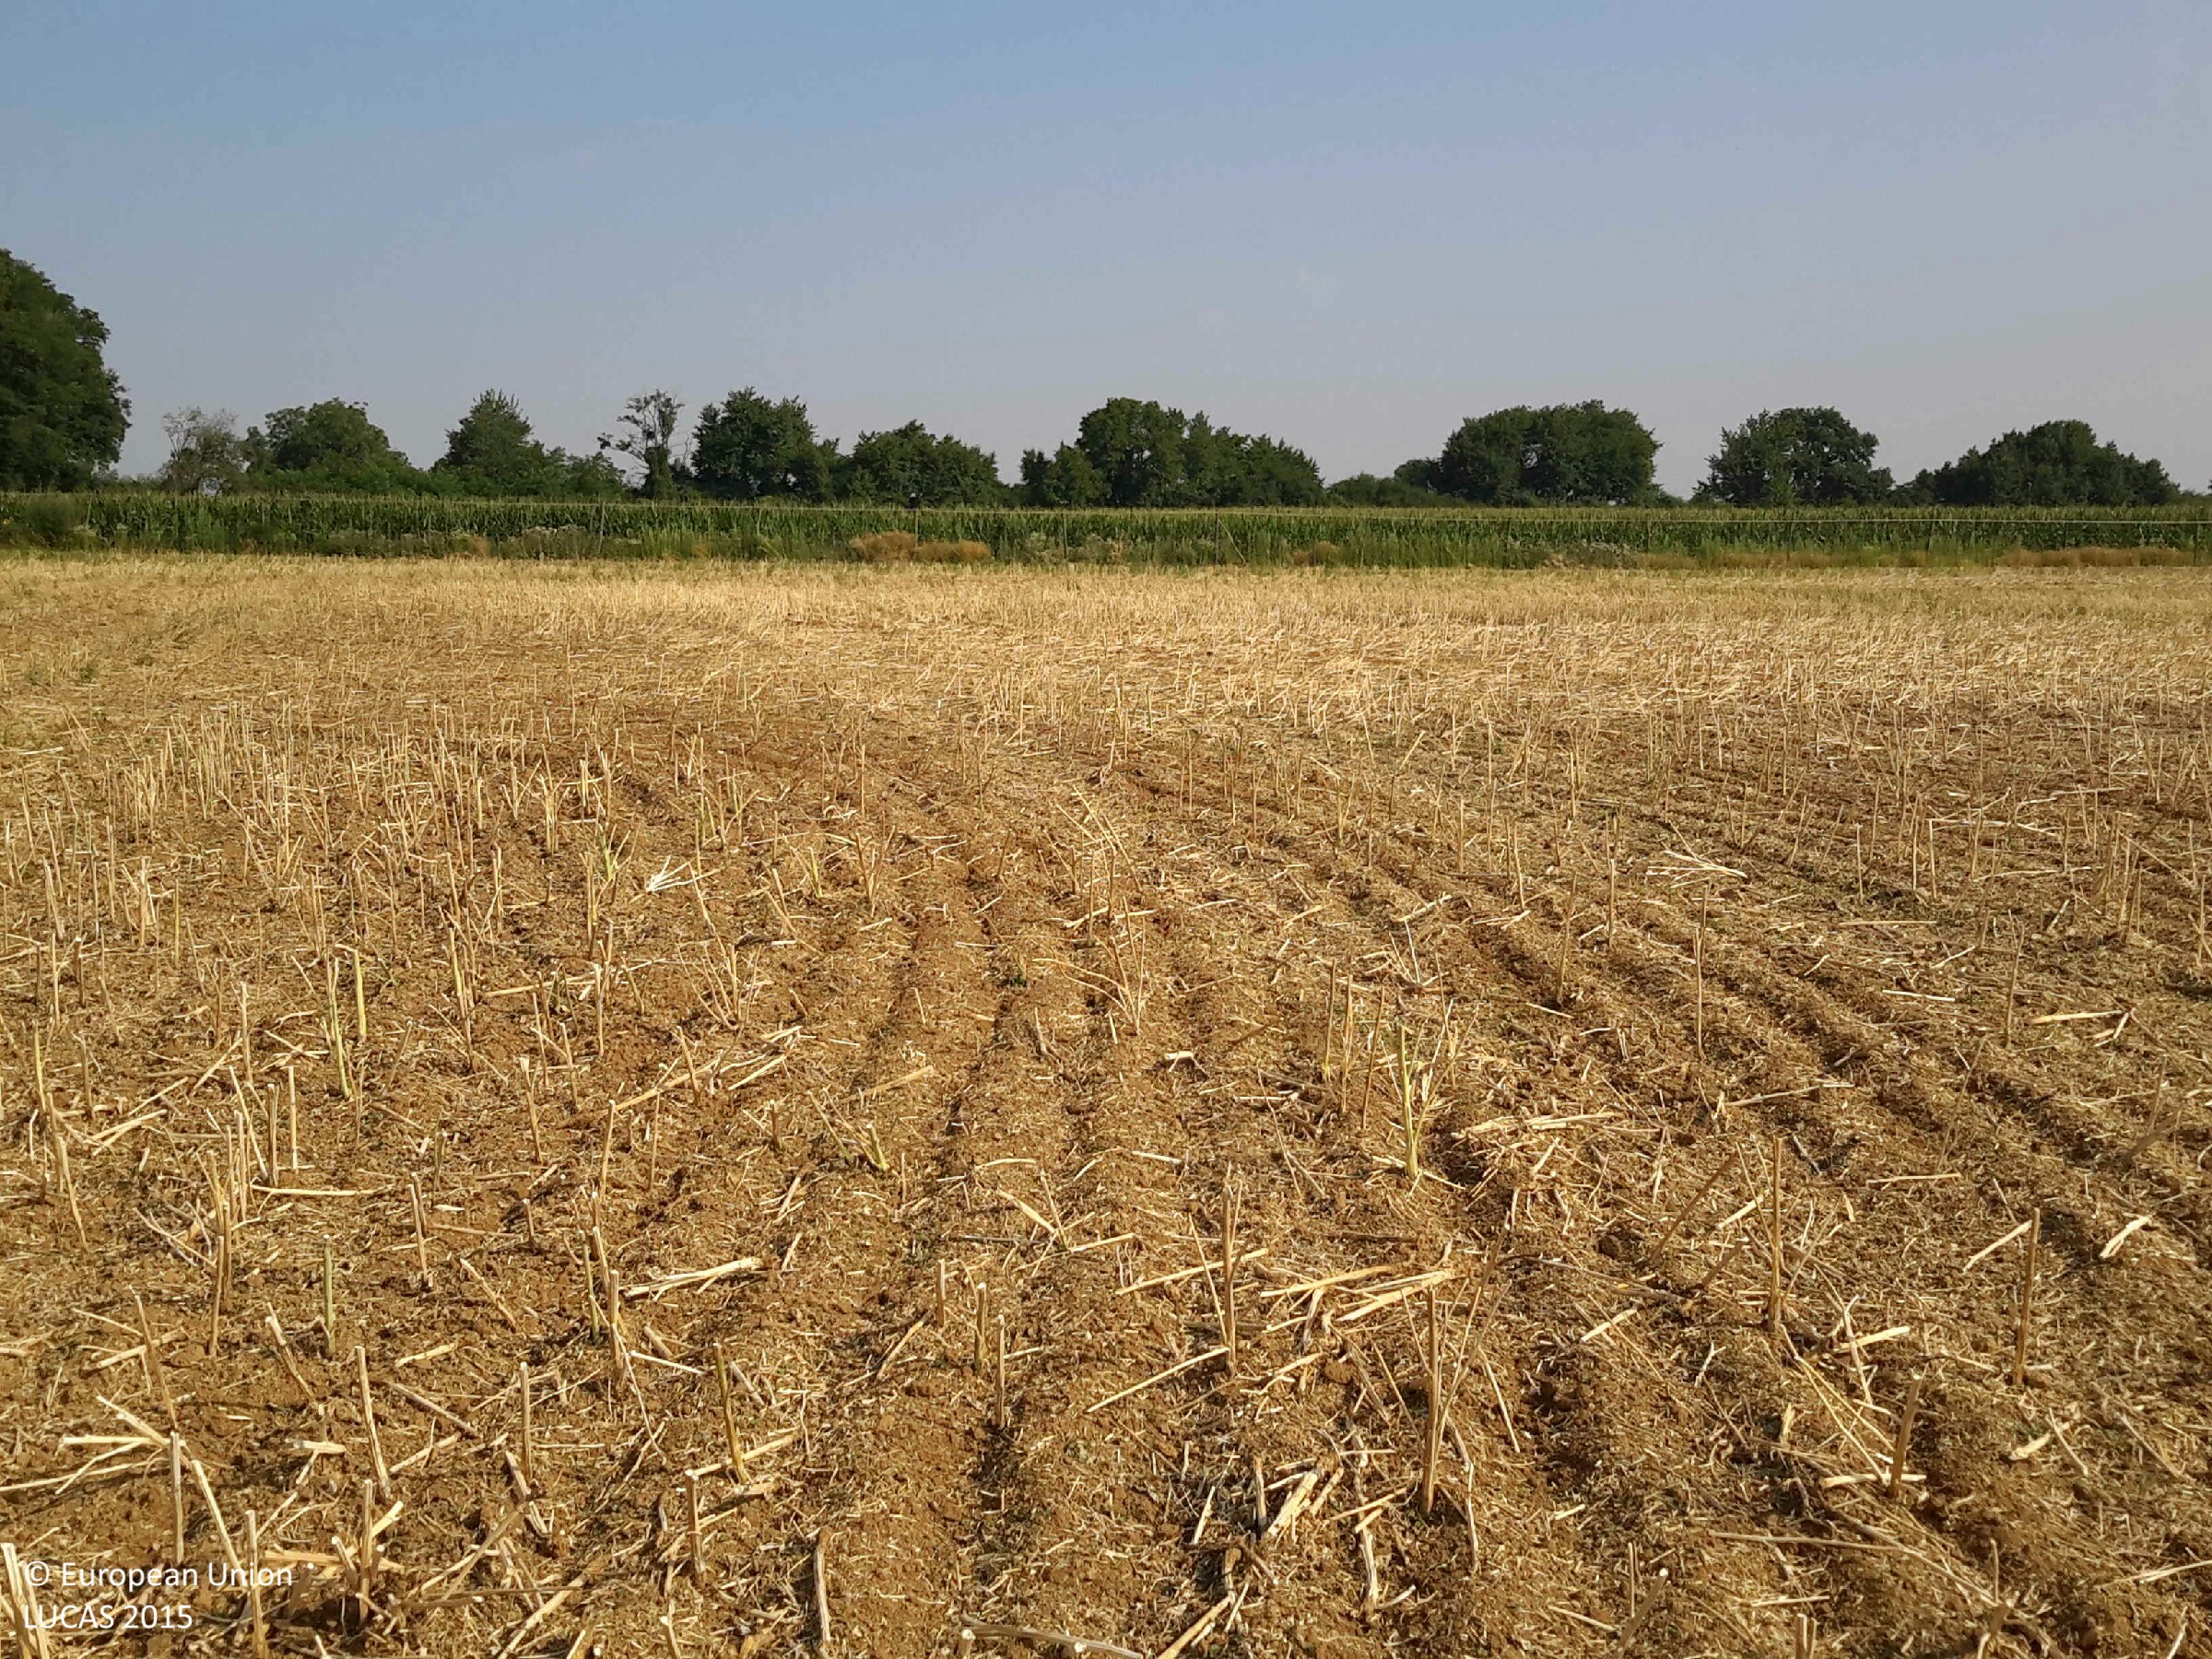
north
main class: Cropland
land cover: Rape and turnip rape
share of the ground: 10 - 25 %
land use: Agriculture (excluding fallow land and kitchen gardens)
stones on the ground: < 10 %
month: July
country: HU
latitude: 47.4450
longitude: 16.6482
